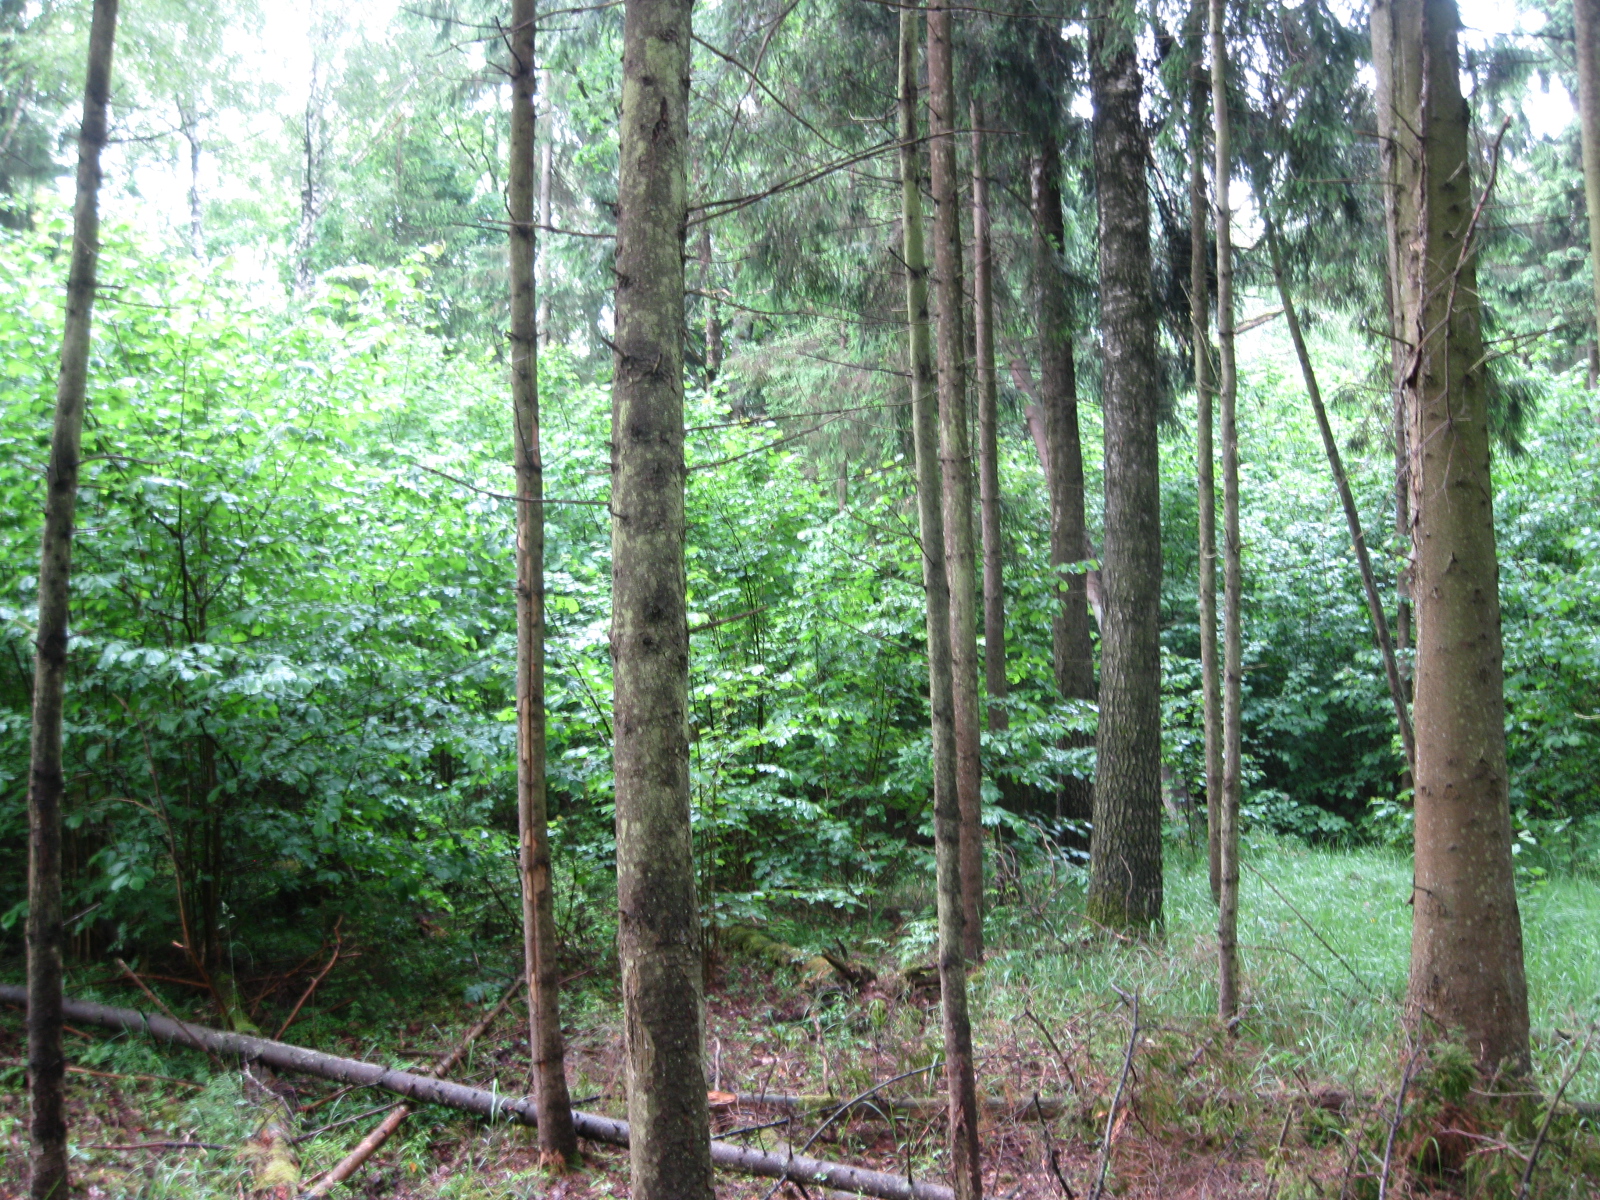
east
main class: Woodland
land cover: Spruce dominated mixed woodland
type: hemiboreal forest and nemoral coniferous forest and mixed broadleaved-coniferous forest
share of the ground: > 75 %
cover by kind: coniferous forest trees 50 %, broadleaved forest trees 30 %, herbaceous plants 20 %
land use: Forestry
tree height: > 5 m
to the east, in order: Spruce dominated mixed woodland; Broadleaved woodland; Spruce dominated mixed woodland
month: June
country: LT
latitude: 55.4033
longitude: 23.7765
